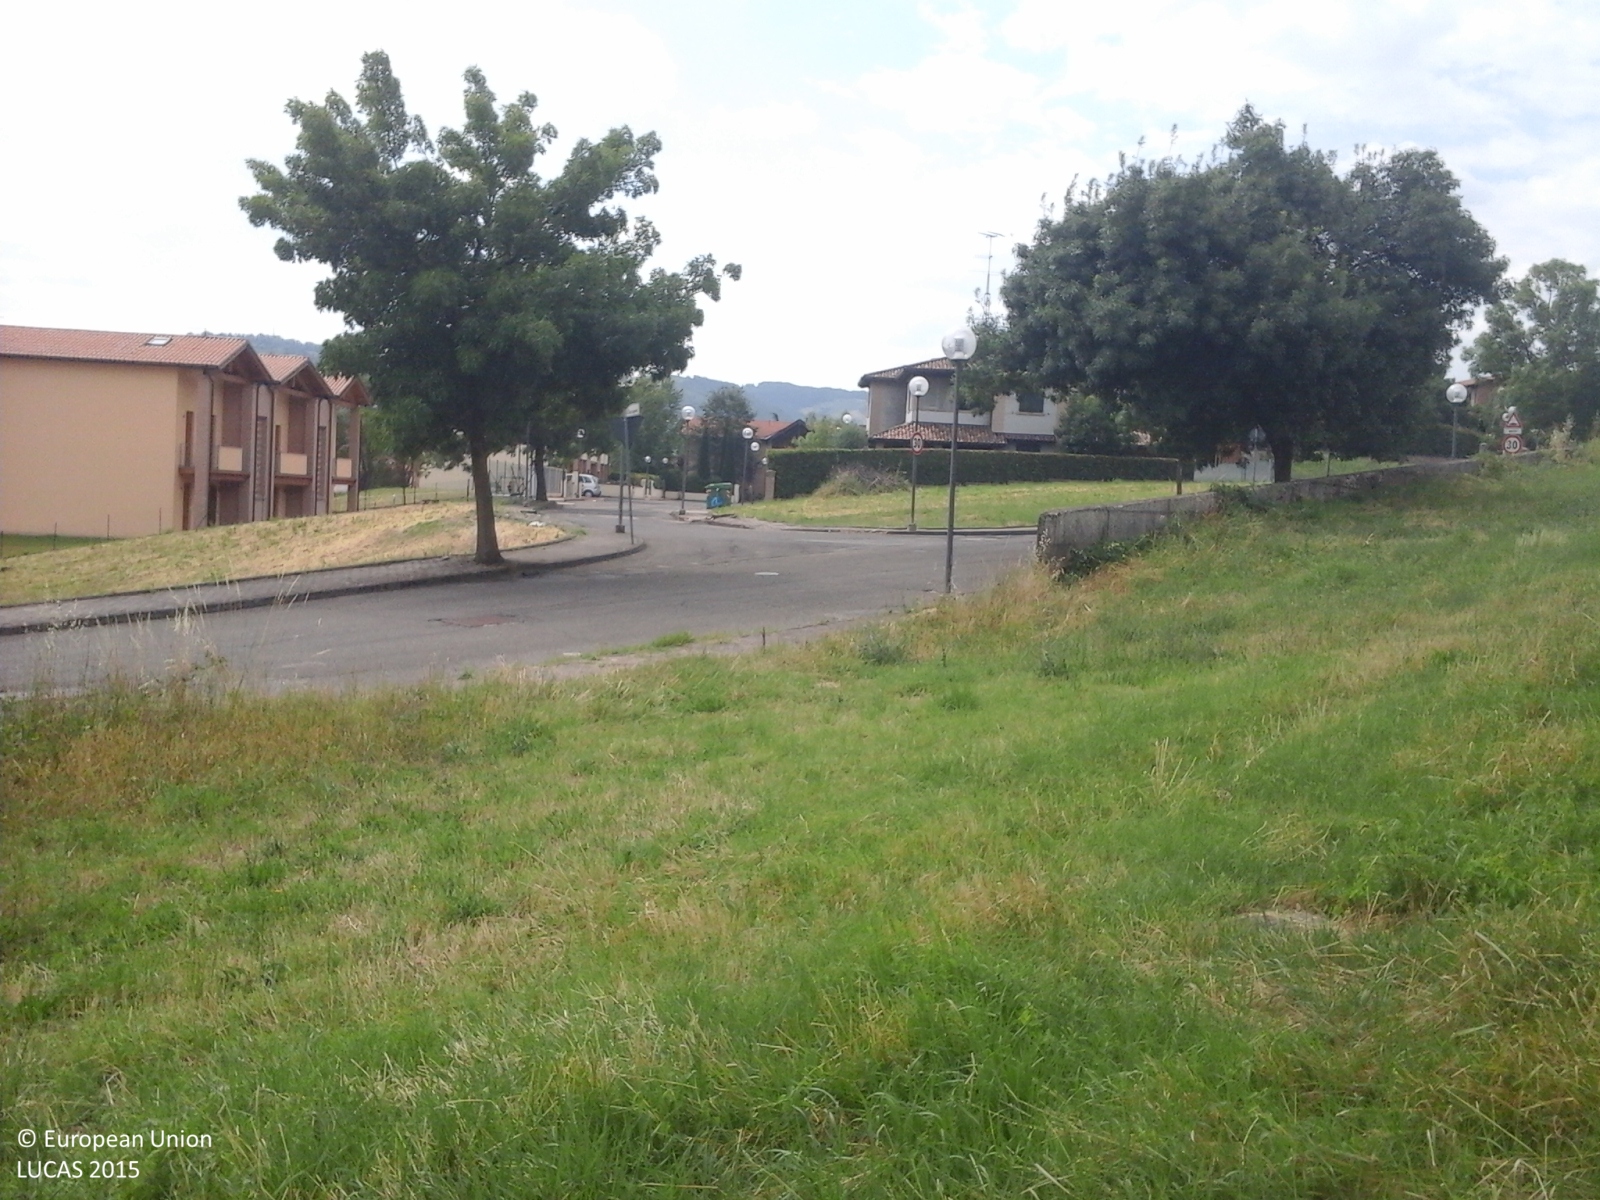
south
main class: Grassland
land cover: Grassland without tree/shrub cover
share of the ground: > 75 %
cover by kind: herbaceous plants 100 %
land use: Agriculture (excluding fallow land and kitchen gardens)
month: June
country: IT
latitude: 44.6207
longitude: 10.2641
